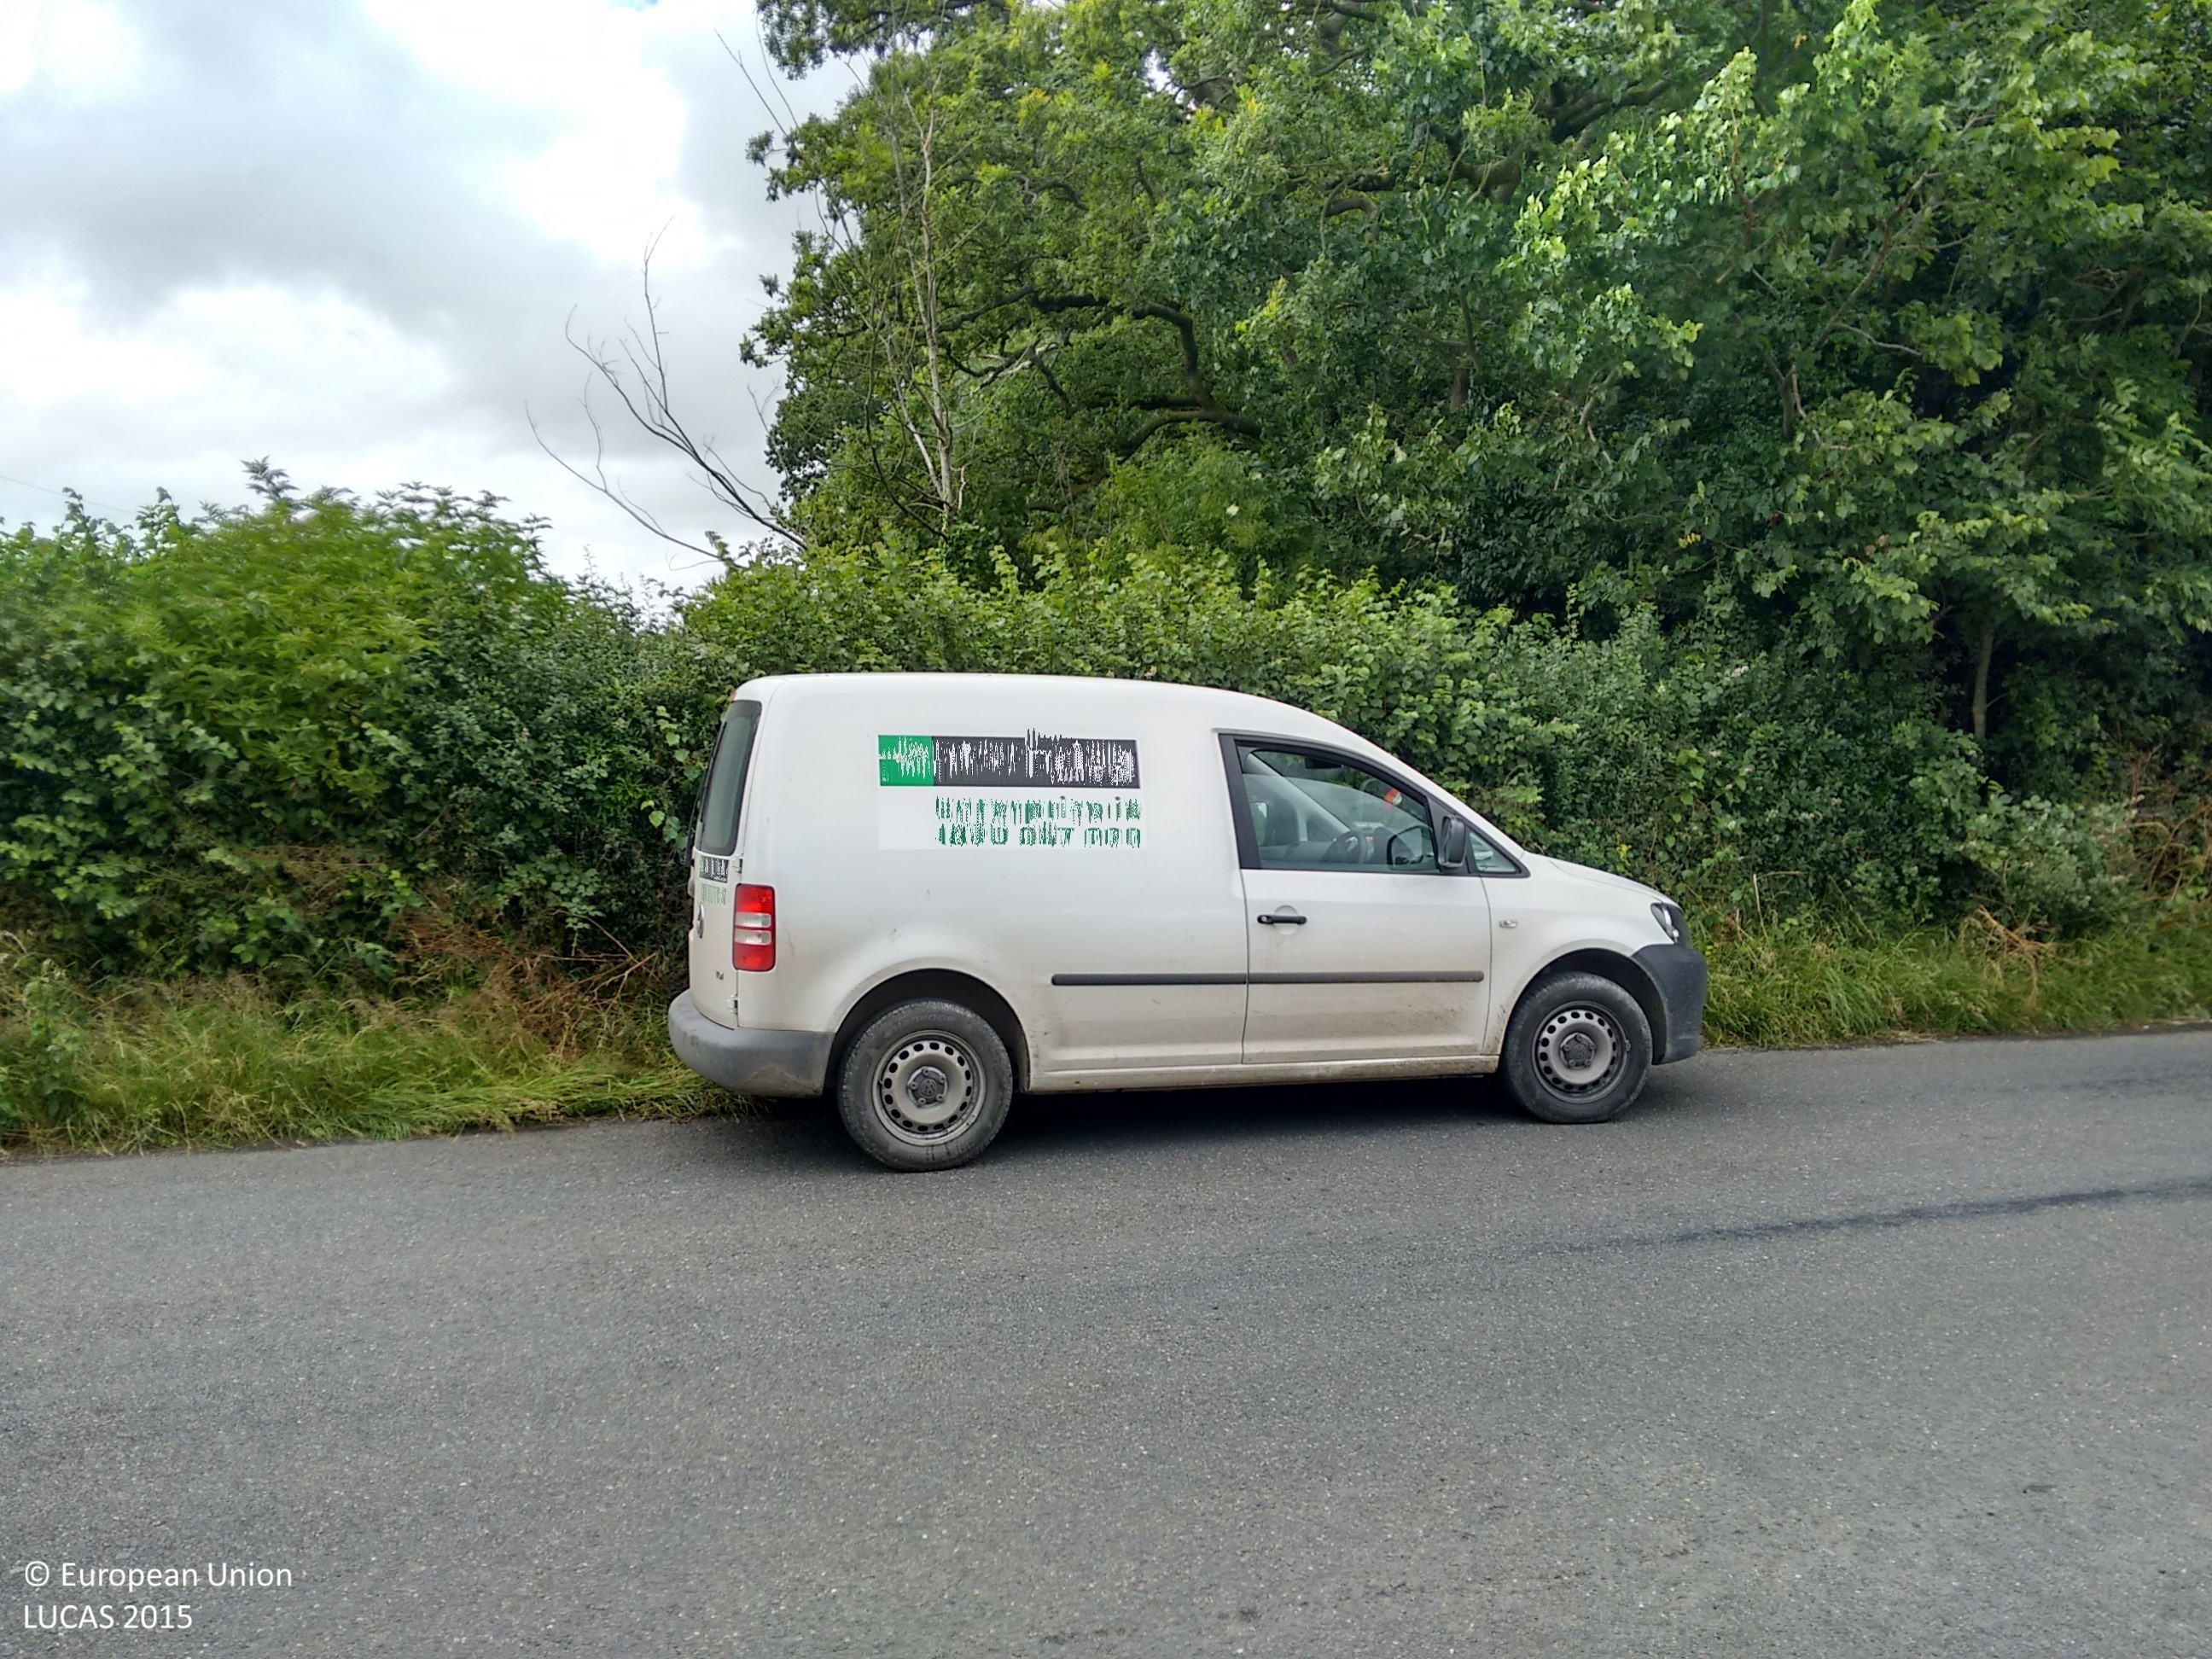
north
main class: Grassland
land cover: Grassland without tree/shrub cover
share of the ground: > 75 %
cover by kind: herbaceous plants 100 %
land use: Agriculture (excluding fallow land and kitchen gardens)
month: July
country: IE
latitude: 52.7164
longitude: -7.2795
